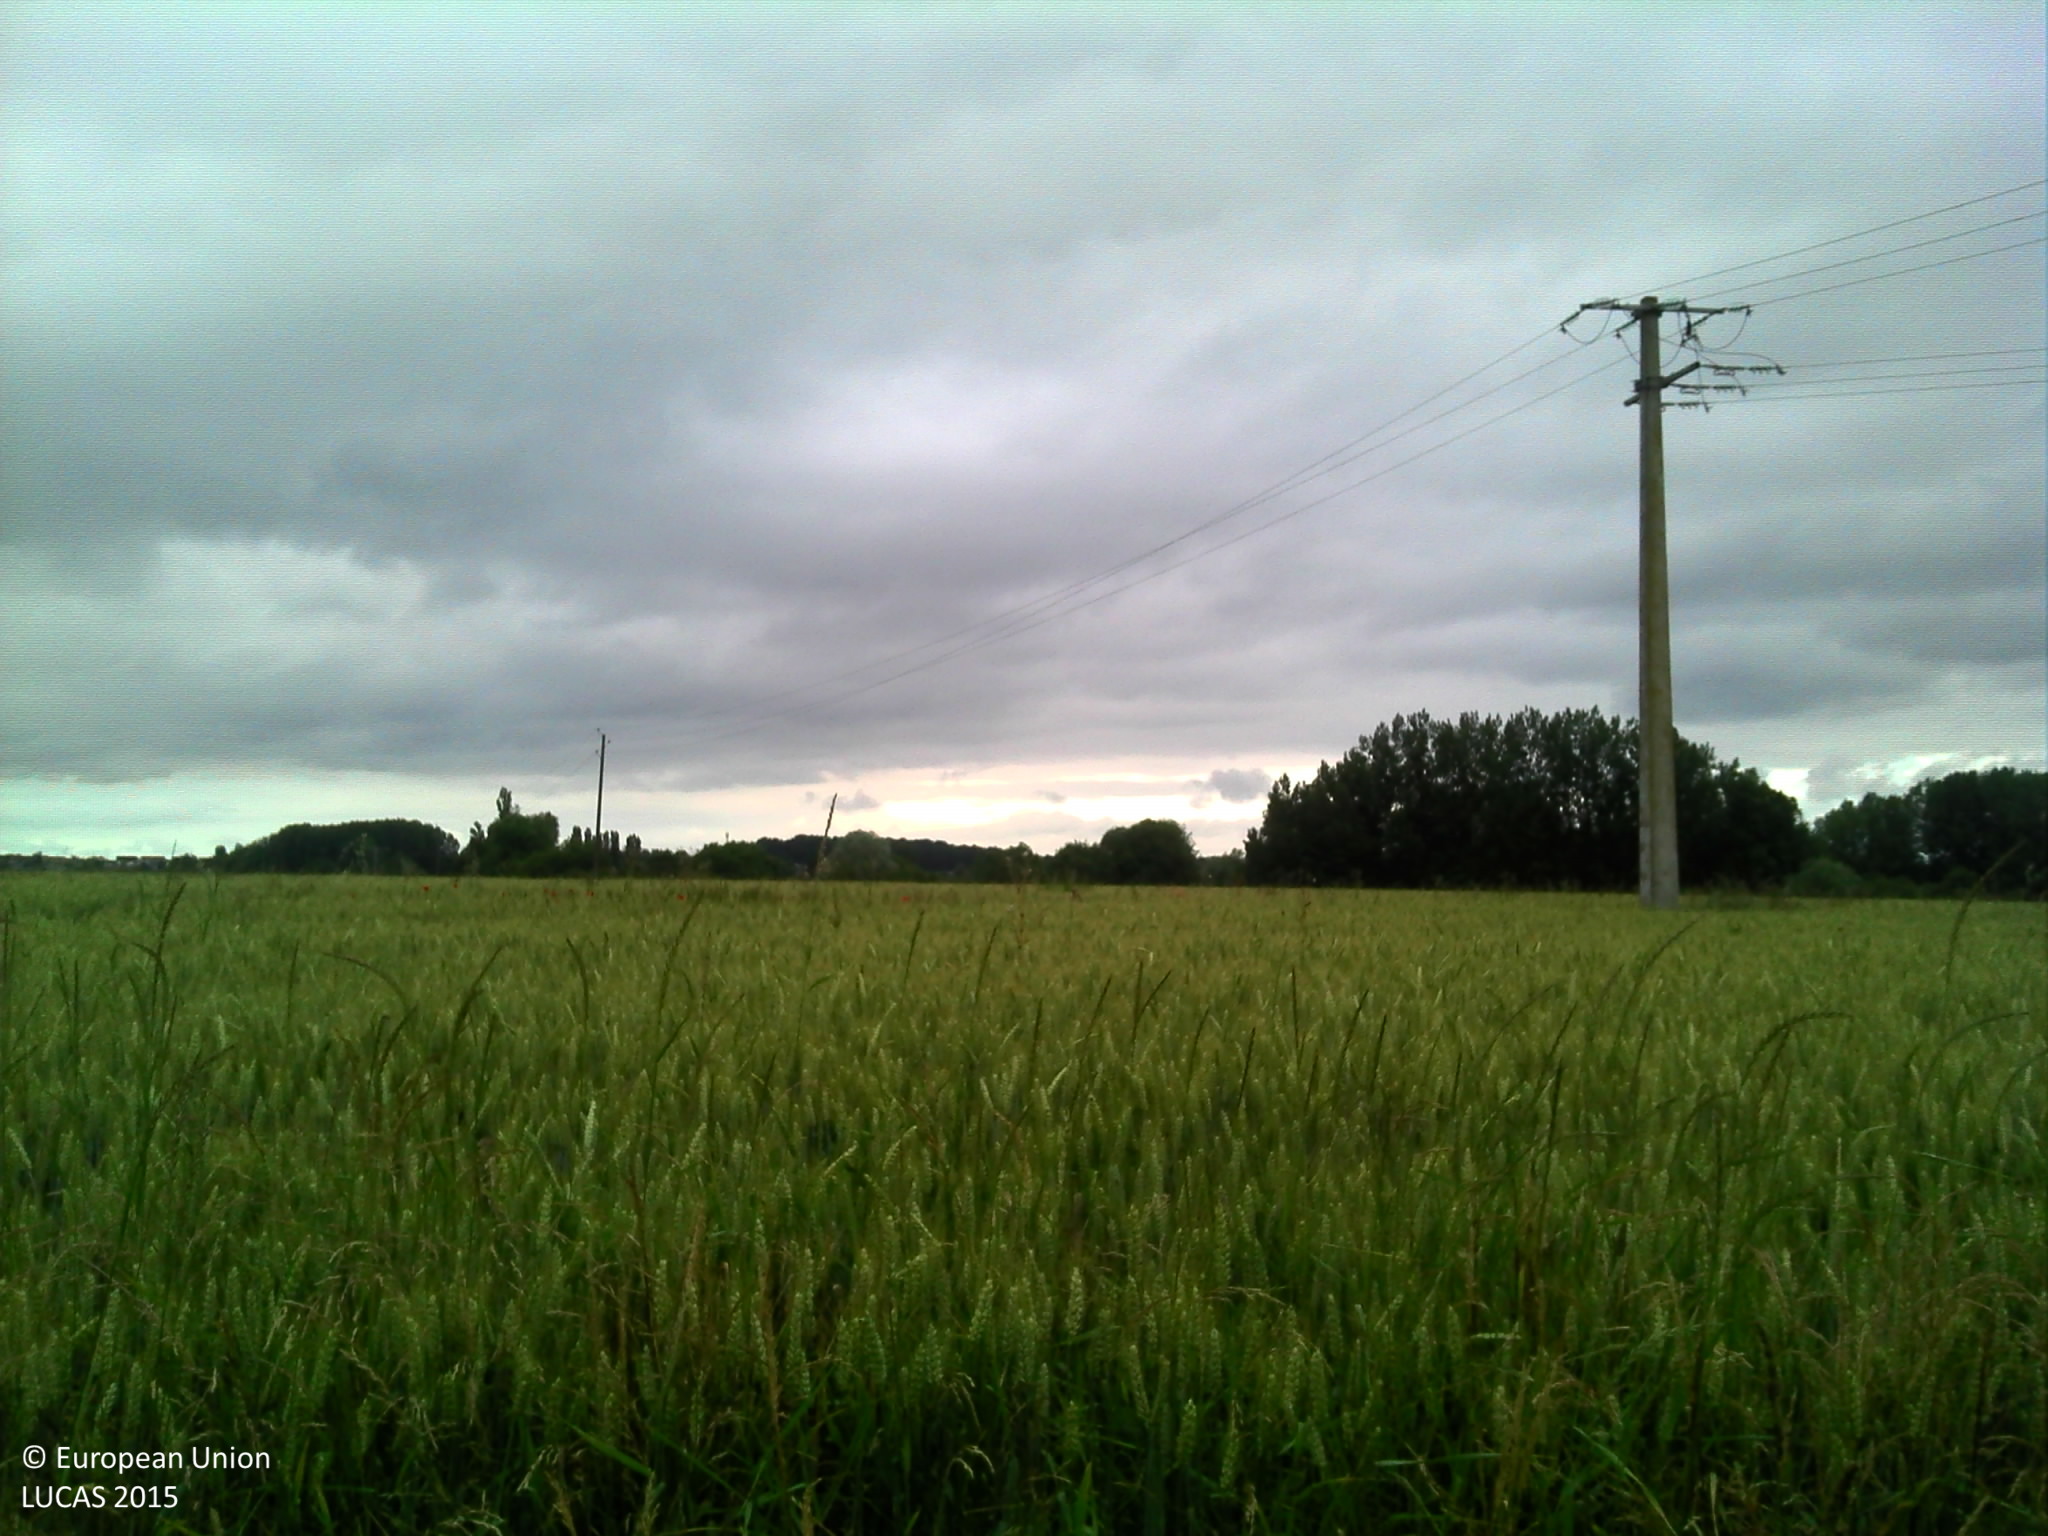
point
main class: Cropland
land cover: Common wheat
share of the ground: > 75 %
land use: Agriculture (excluding fallow land and kitchen gardens)
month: June
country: FR
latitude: 48.1486
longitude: 0.2018
